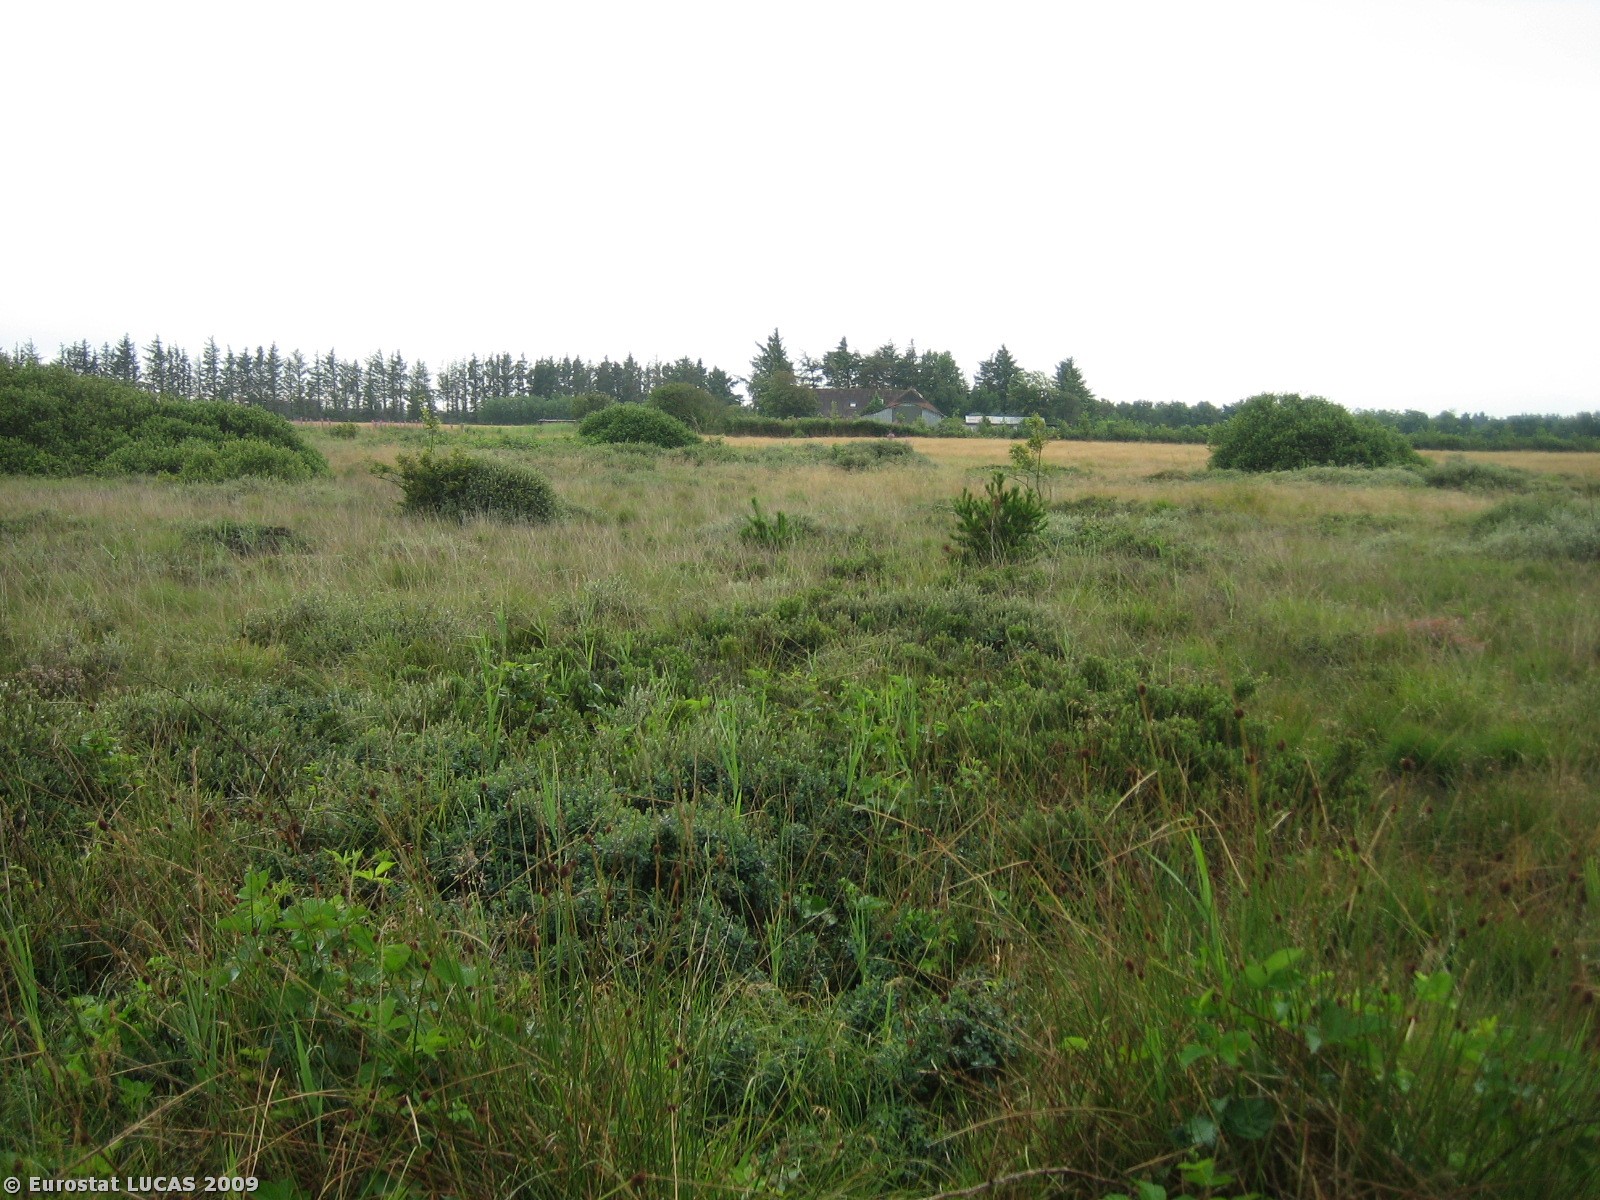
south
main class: Shrubland
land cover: Shrubland with sparse tree cover
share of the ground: > 75 %
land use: Unused
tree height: > 5 m
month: July
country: DK
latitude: 55.6906
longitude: 8.2676
